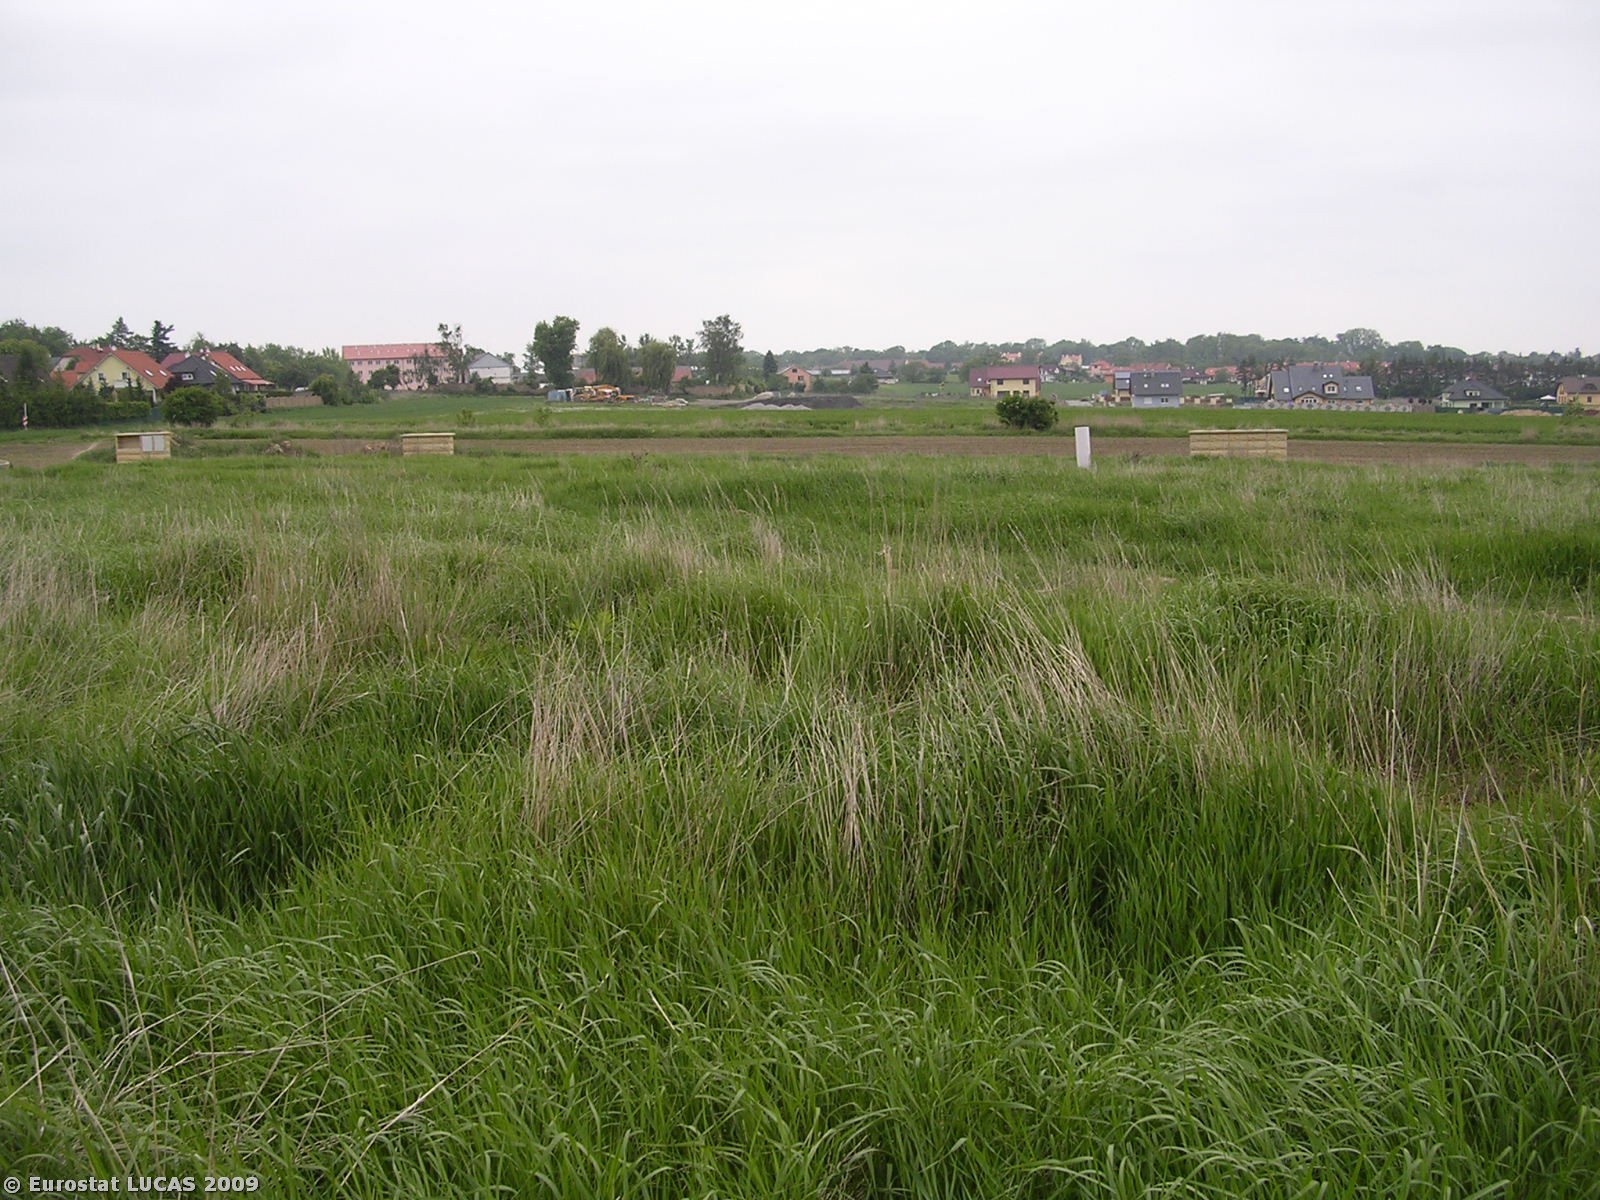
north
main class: Grassland
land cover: Grassland without tree/shrub cover
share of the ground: > 75 %
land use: Fallow land
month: May
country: CZ
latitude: 50.1060
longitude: 14.6860
